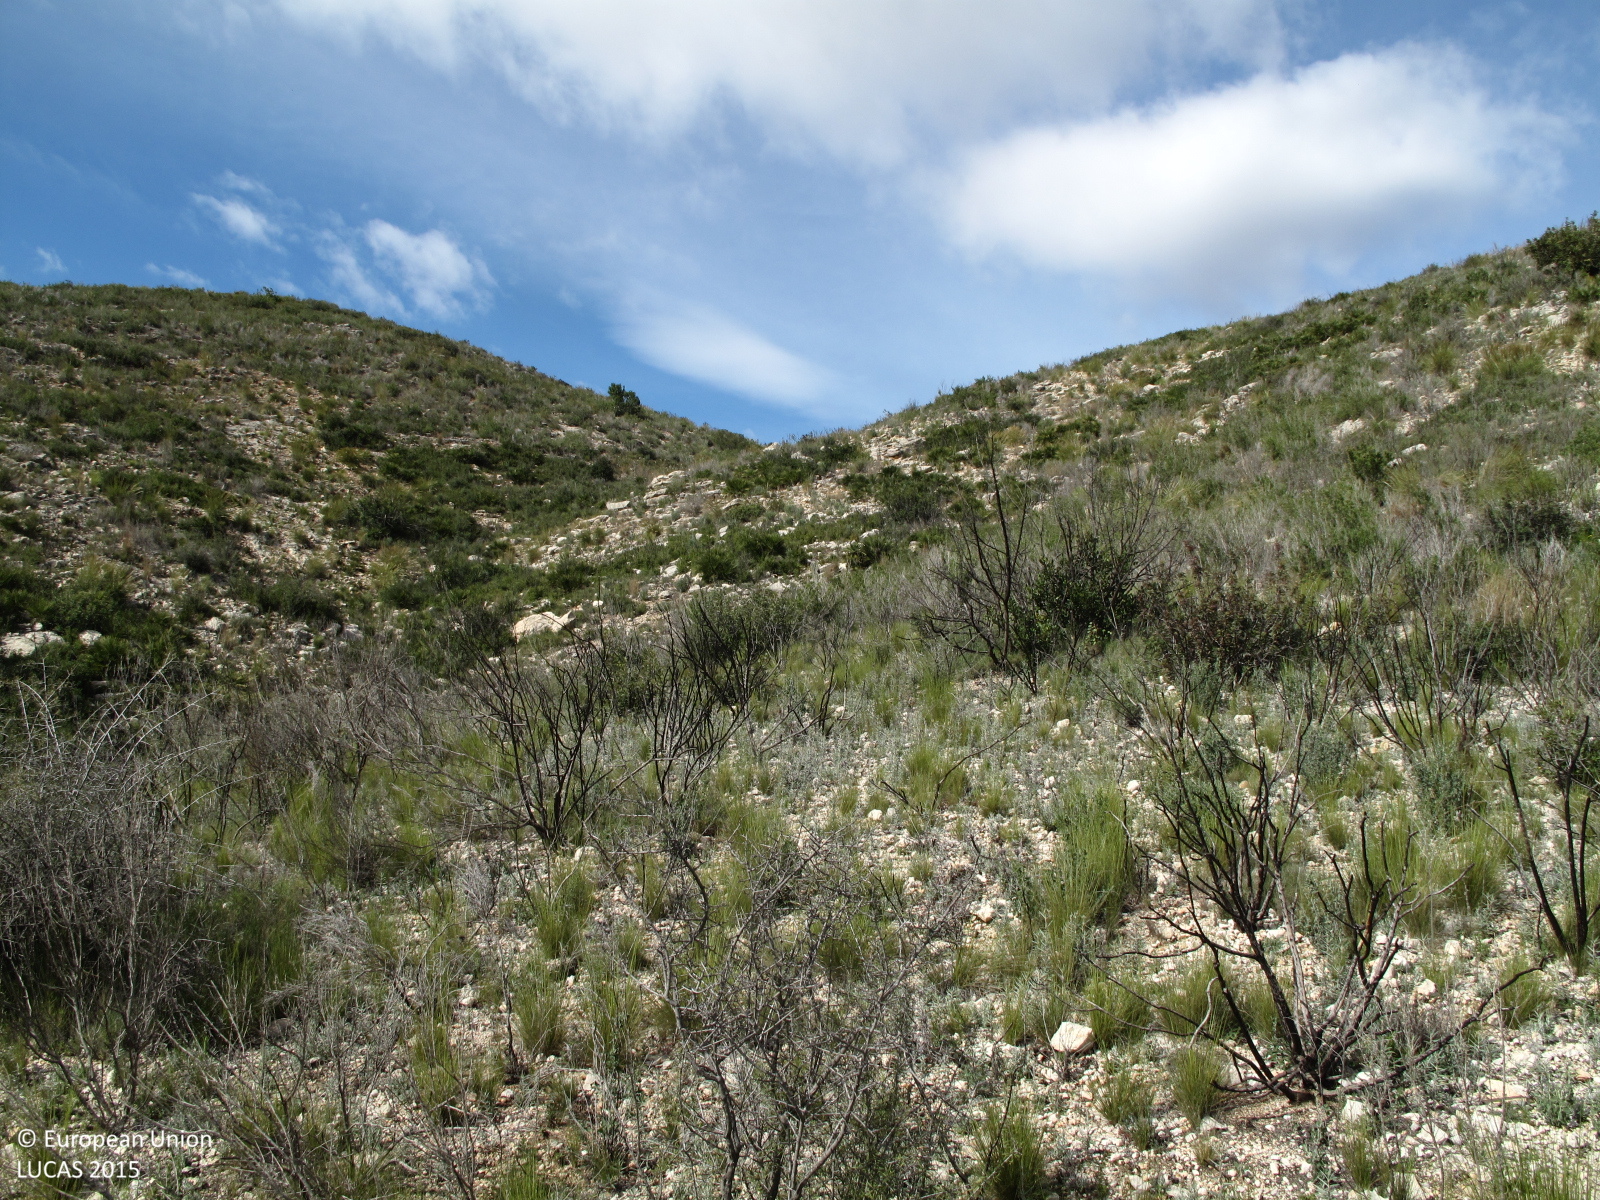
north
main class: Shrubland
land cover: Shrubland without tree cover
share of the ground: 50 - 75 %
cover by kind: shrubs 50 %, herbaceous plants 25 %, consolidated bare surface 25 %
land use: Semi-natural and natural areas not in use
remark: Burnt area
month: March
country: ES
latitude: 39.1949
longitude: -0.6362
